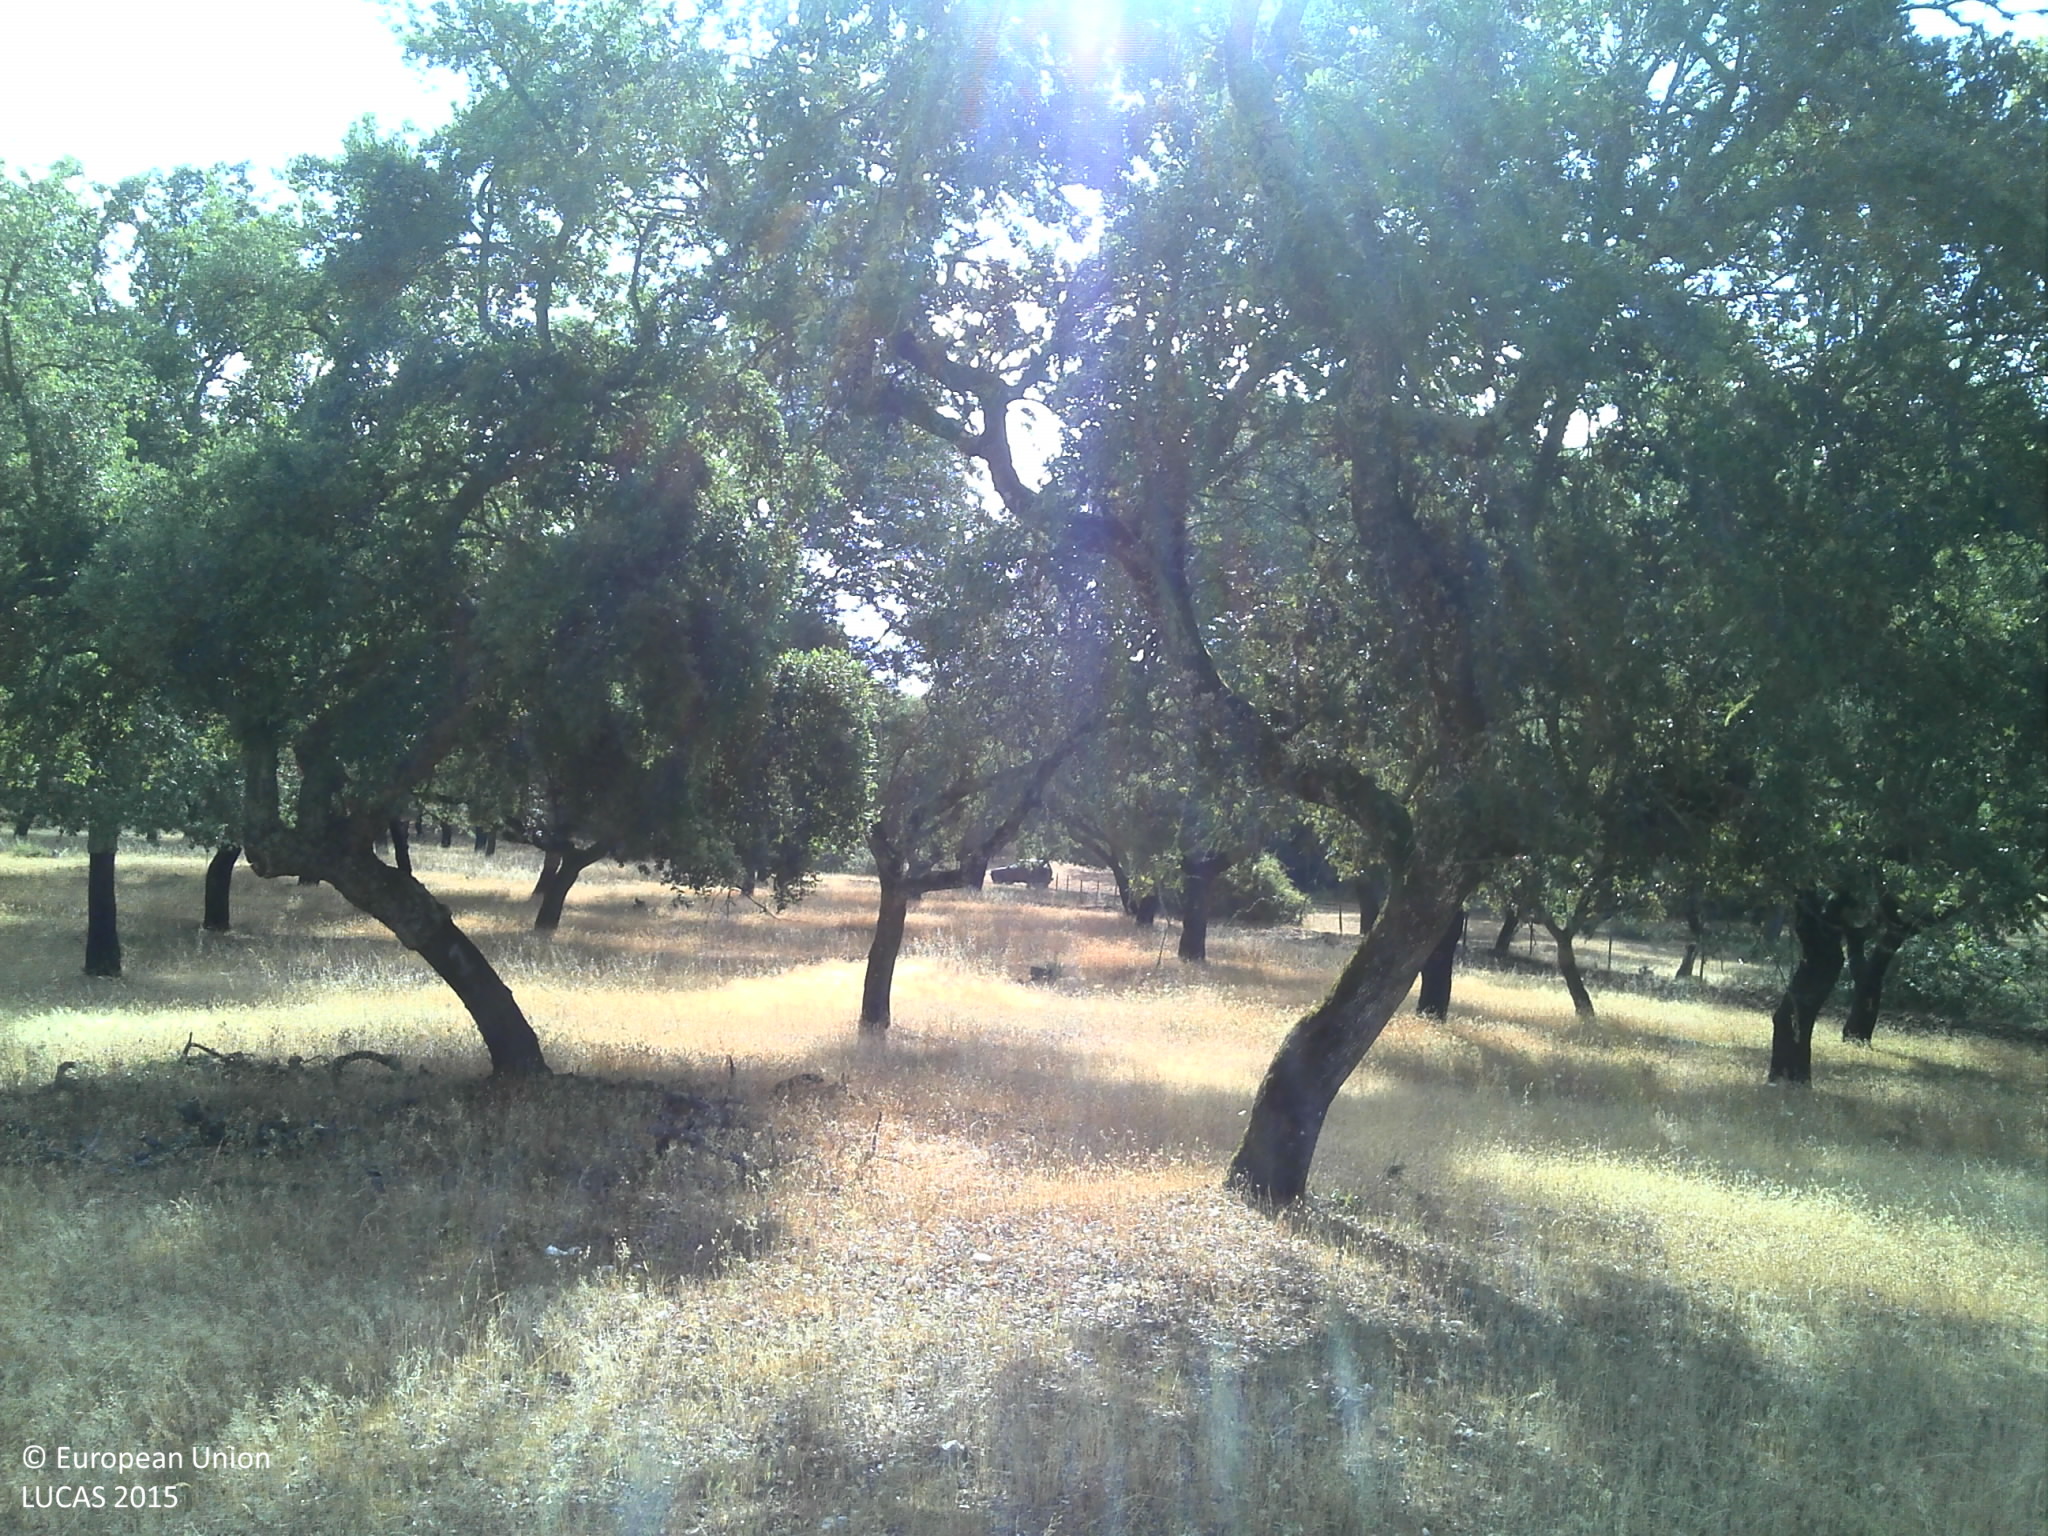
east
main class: Woodland
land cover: Broadleaved woodland
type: broadleaved evergreen forest
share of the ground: 10 - 25 %
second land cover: Spontaneously vegetated surfaces
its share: 25 - 50 %
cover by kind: herbaceous plants 50 %, unconsolidated bare surface 40 %, broadleaved forest trees 10 %
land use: Forestry
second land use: Agriculture (excluding fallow land and kitchen gardens)
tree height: > 5 m
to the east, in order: Broadleaved woodland; Spontaneously vegetated surfaces; Broadleaved woodland; Fences; Broadleaved woodland
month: June
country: PT
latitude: 38.5811
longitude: -8.0307
